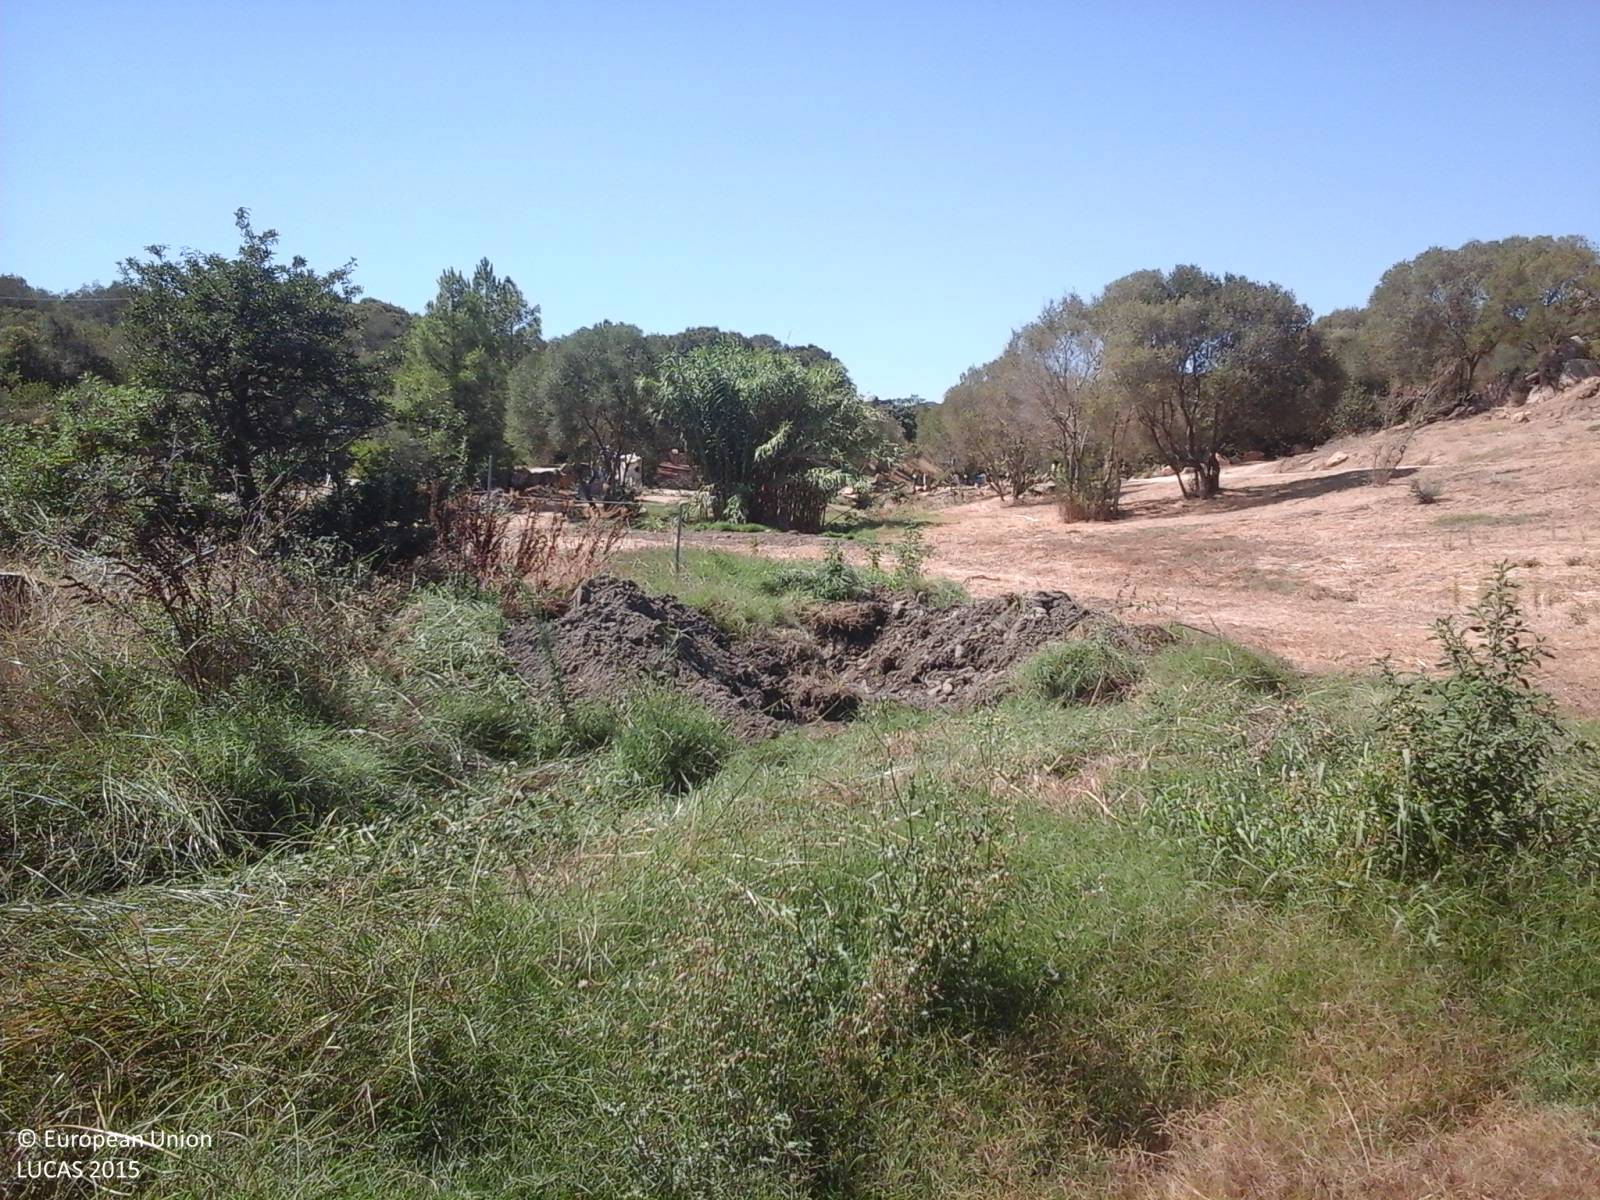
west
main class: Grassland
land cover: Grassland without tree/shrub cover
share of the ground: > 75 %
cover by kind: herbaceous plants 95 %, unconsolidated bare surface 5 %
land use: Agriculture (excluding fallow land and kitchen gardens)
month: August
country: IT
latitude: 41.0256
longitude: 9.4199
